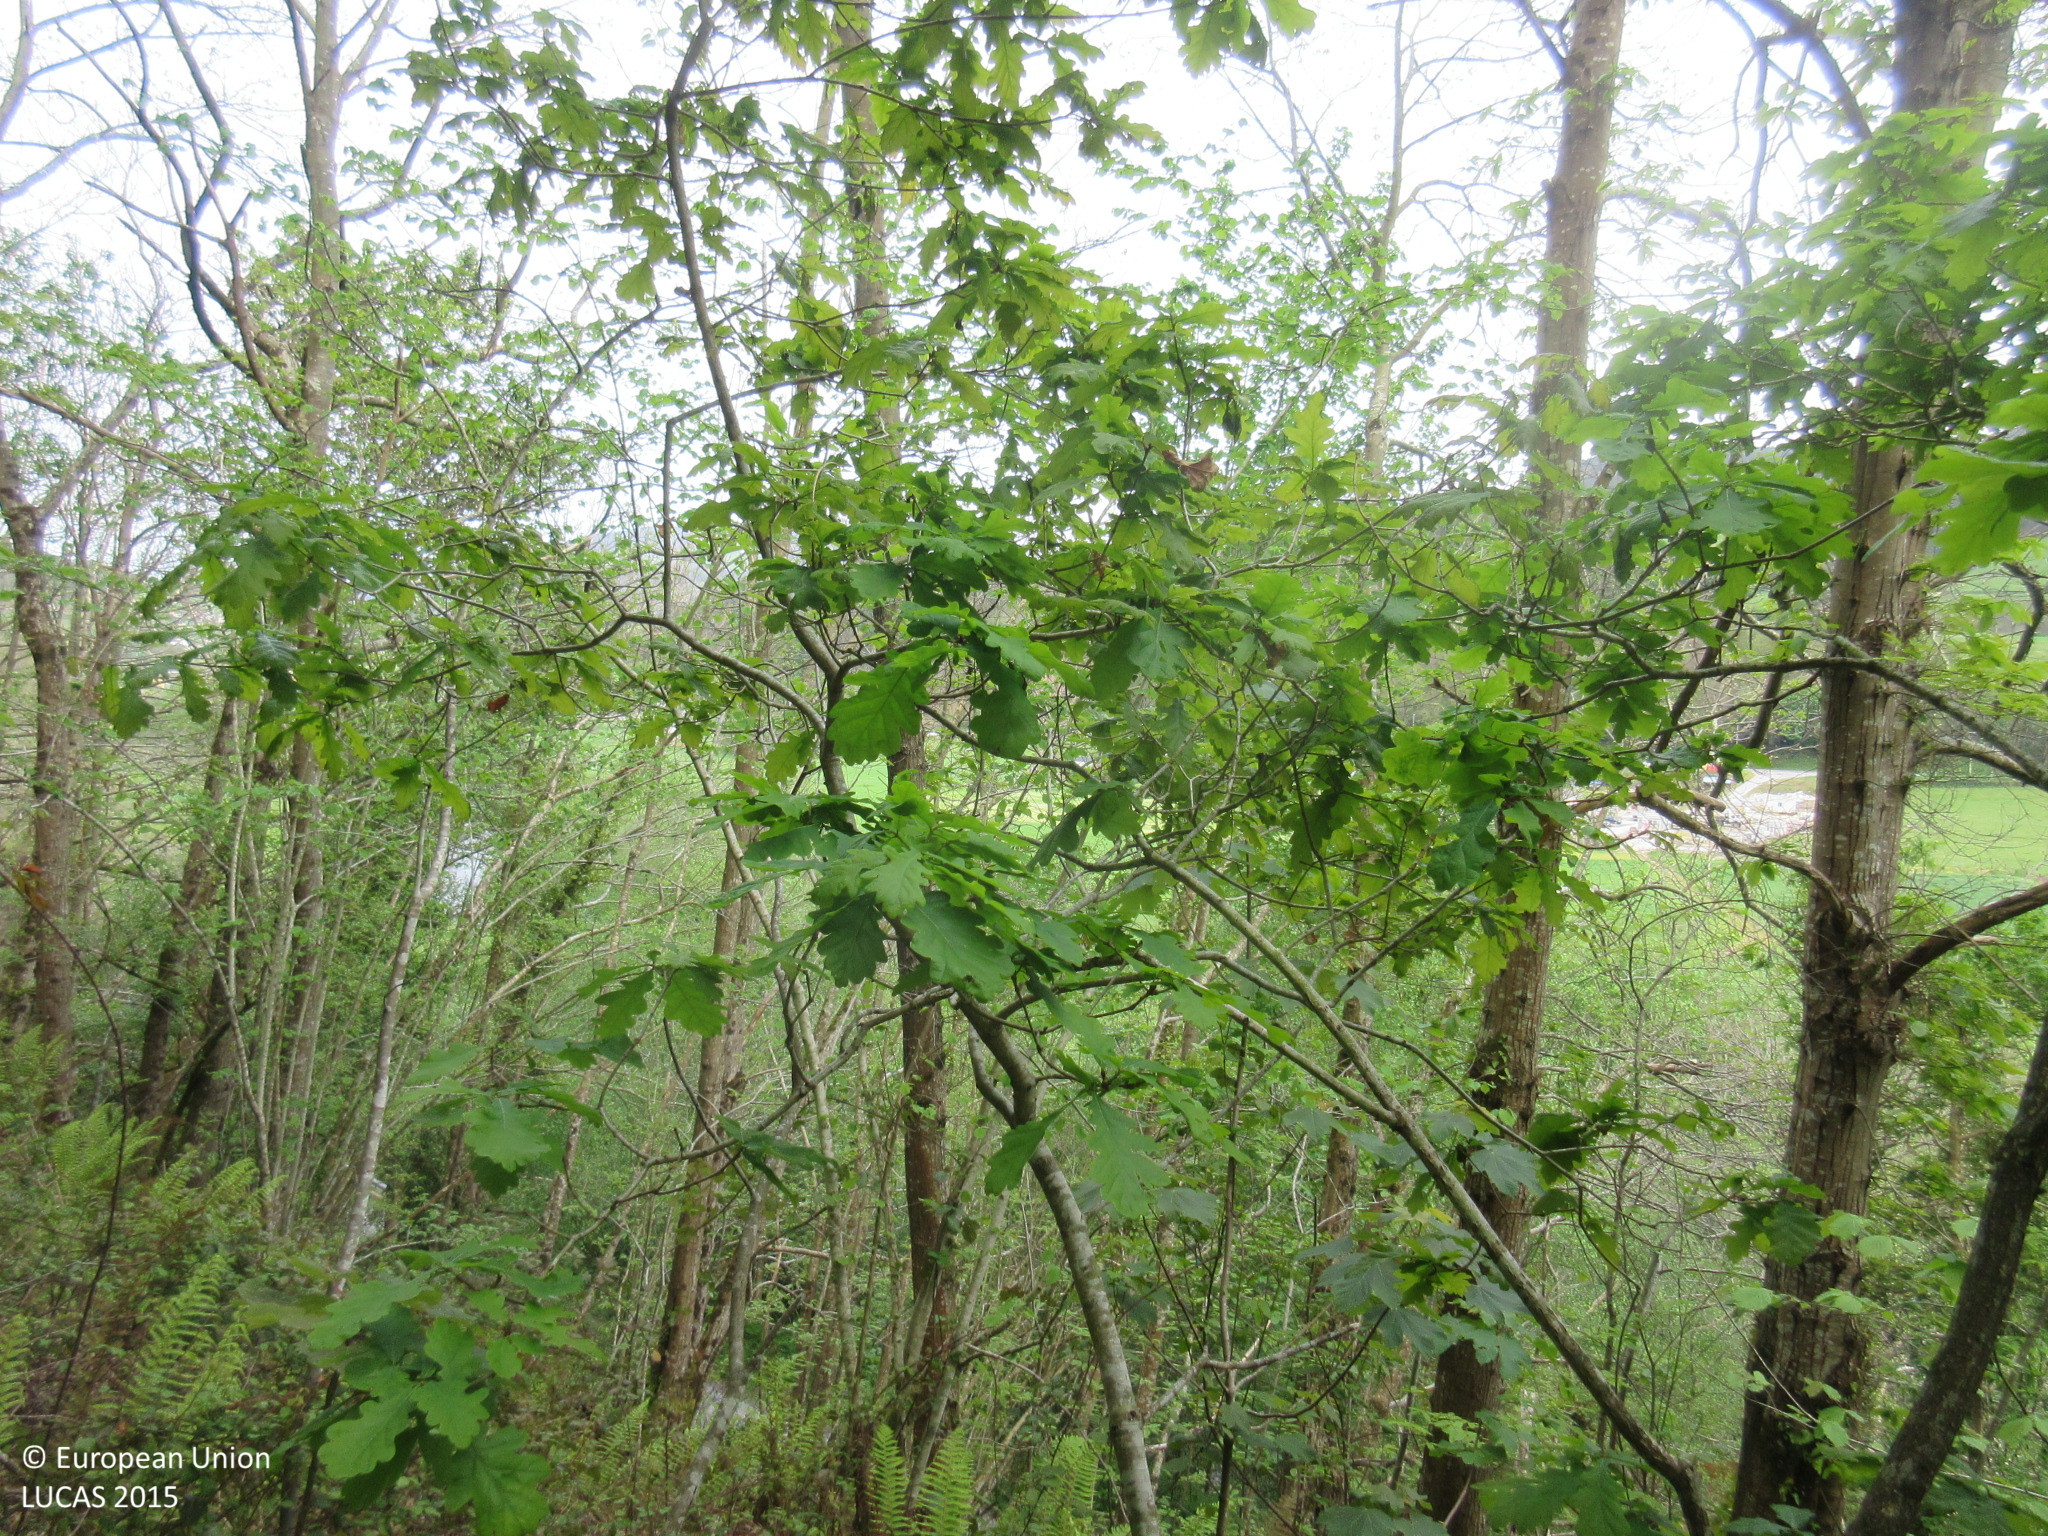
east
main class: Woodland
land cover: Broadleaved woodland
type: acidophilous oak and oak-birch forest
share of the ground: > 75 %
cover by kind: broadleaved forest trees 100 %
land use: Forestry
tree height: > 5 m
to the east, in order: Broadleaved woodland; Grass margins; Paved roads, cycling and walking lanes; Broadleaved woodland; Inland fresh running water; Paved roads, cycling and walking lanes; Inland fresh running water; Broadleaved woodland; Grassland without tree/shrub cover
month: April
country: ES
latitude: 43.5059
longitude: -6.4423
